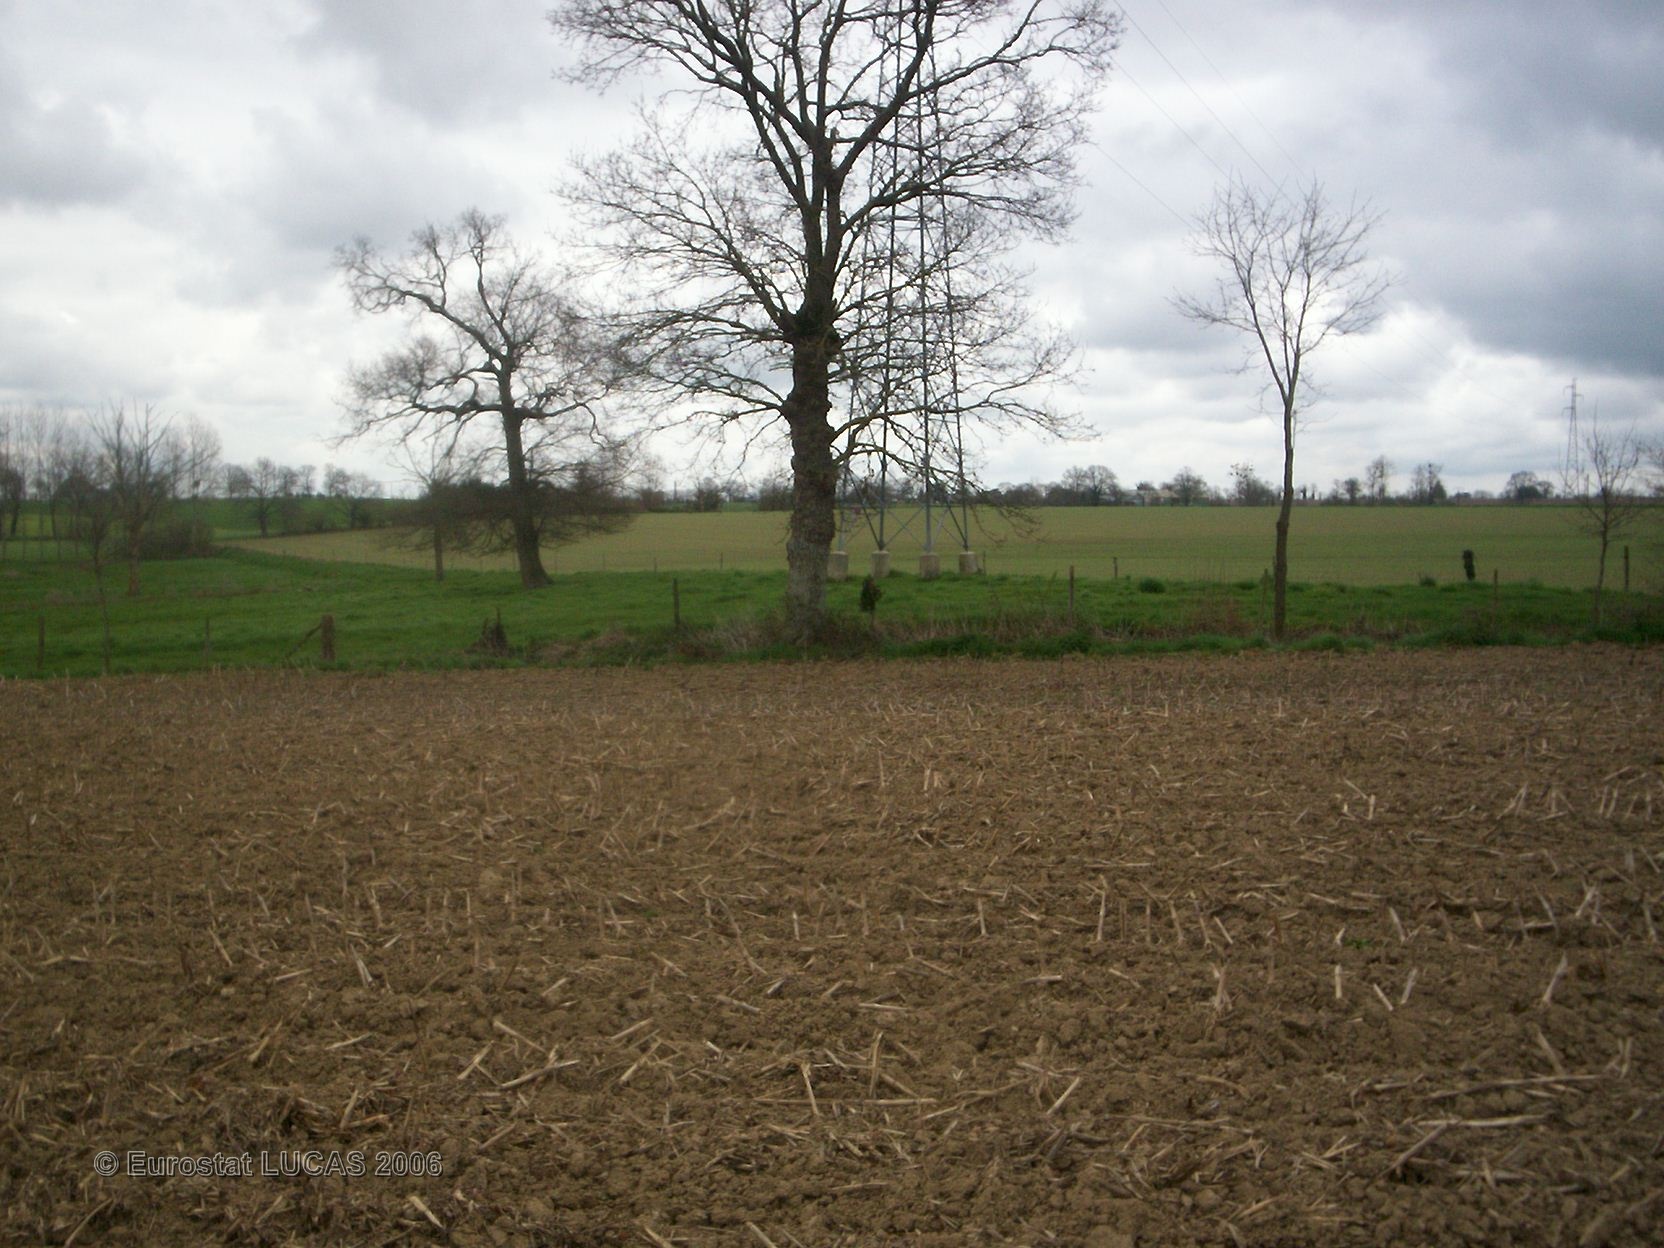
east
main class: Cropland
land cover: Maize
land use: Agriculture (excluding fallow land and kitchen gardens)
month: April
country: FR
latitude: 47.9490
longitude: -1.3029
